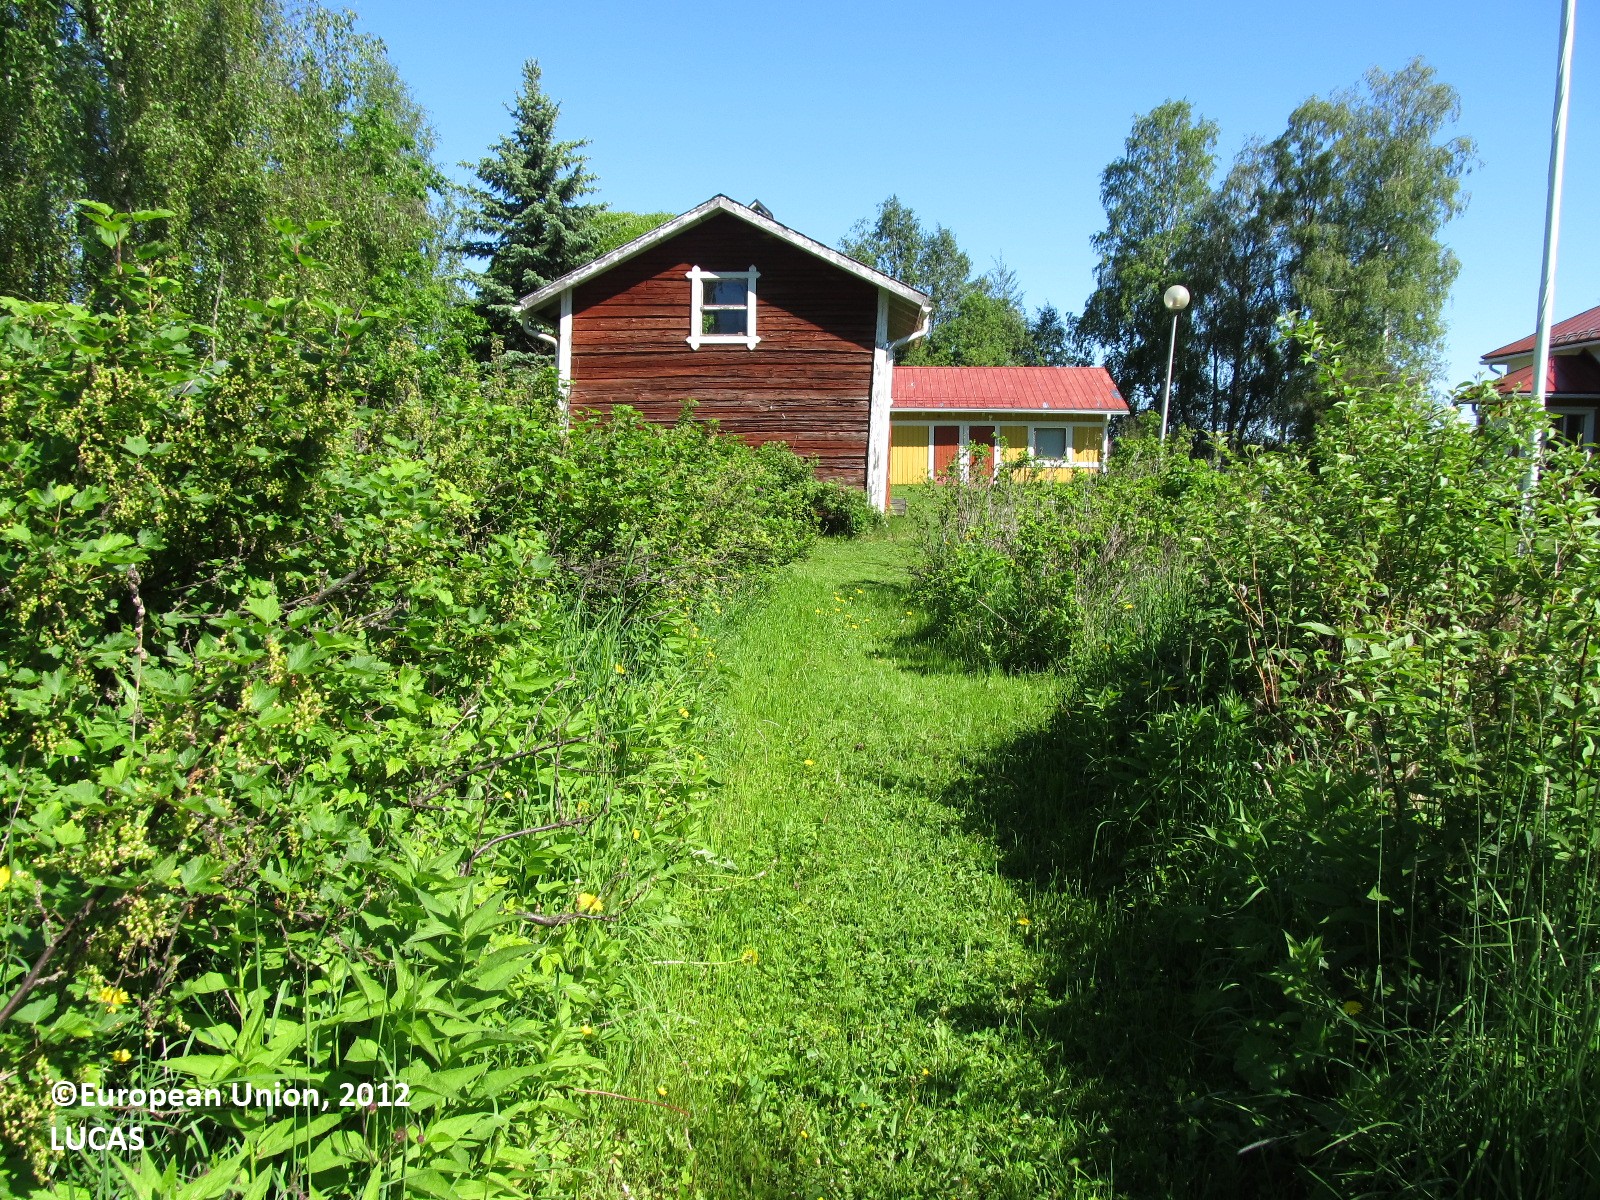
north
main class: Cropland
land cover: Other fruit trees and berries
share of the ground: 50 - 75 %
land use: Kitchen garden
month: June
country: FI
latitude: 62.9661
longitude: 27.8226
